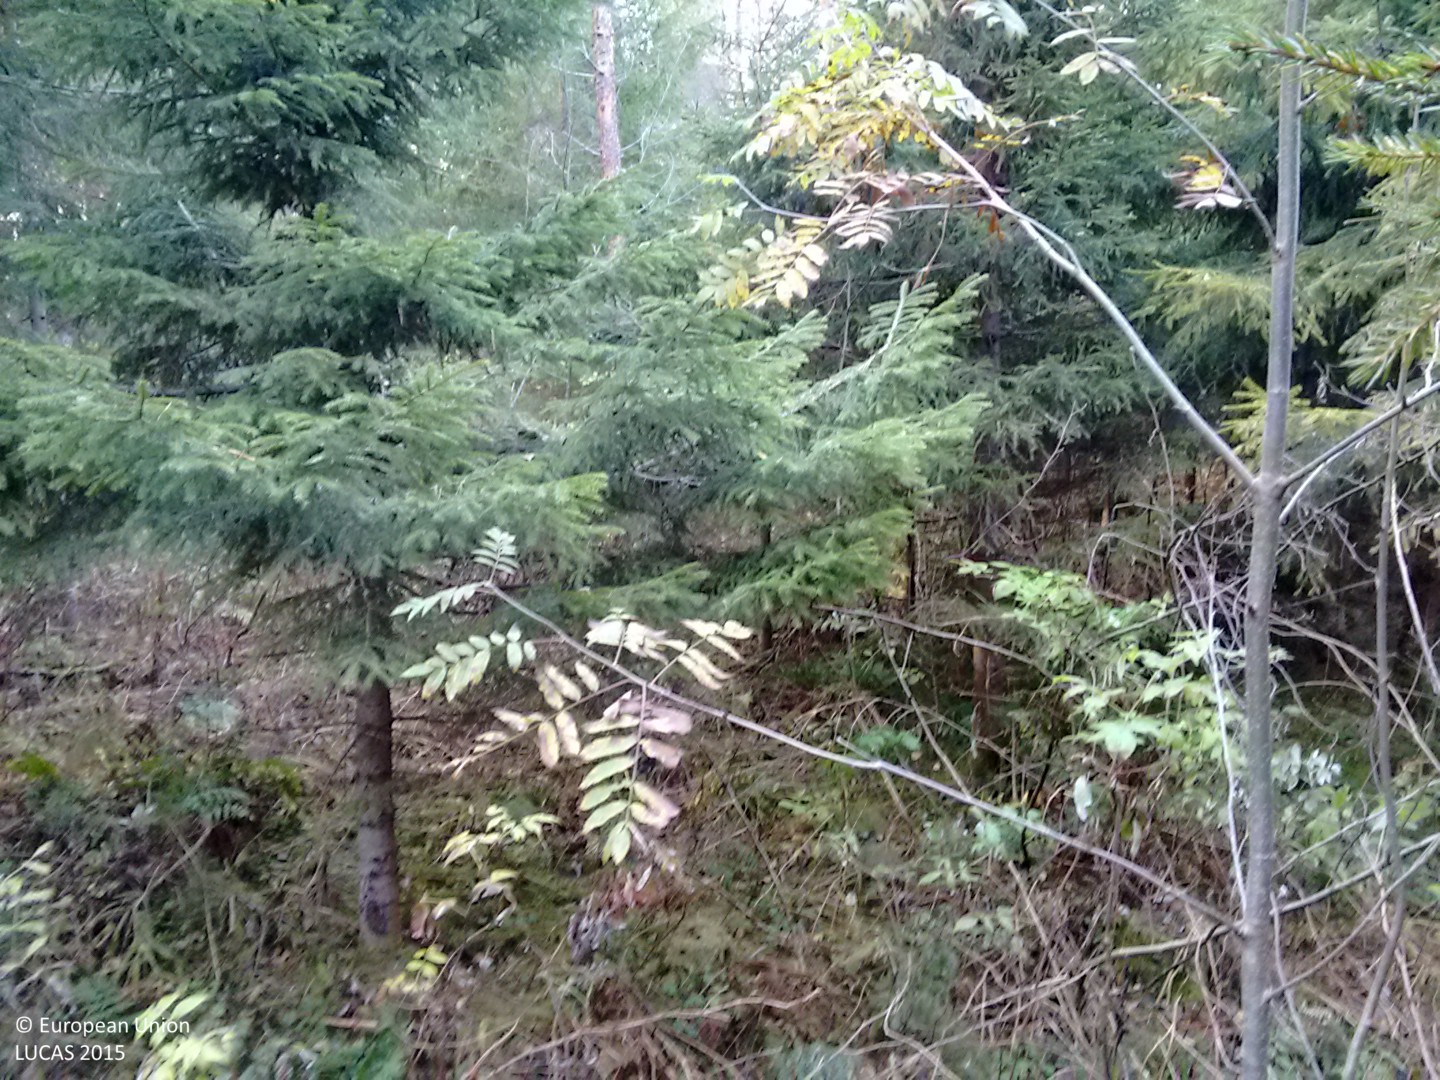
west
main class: Woodland
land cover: Spruce dominated coniferous woodland
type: hemiboreal forest and nemoral coniferous forest and mixed broadleaved-coniferous forest
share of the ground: > 75 %
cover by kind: coniferous forest trees 90 %, shrubs 10 %
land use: Forestry
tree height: > 5 m
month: October
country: FI
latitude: 62.6805
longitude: 25.9206
